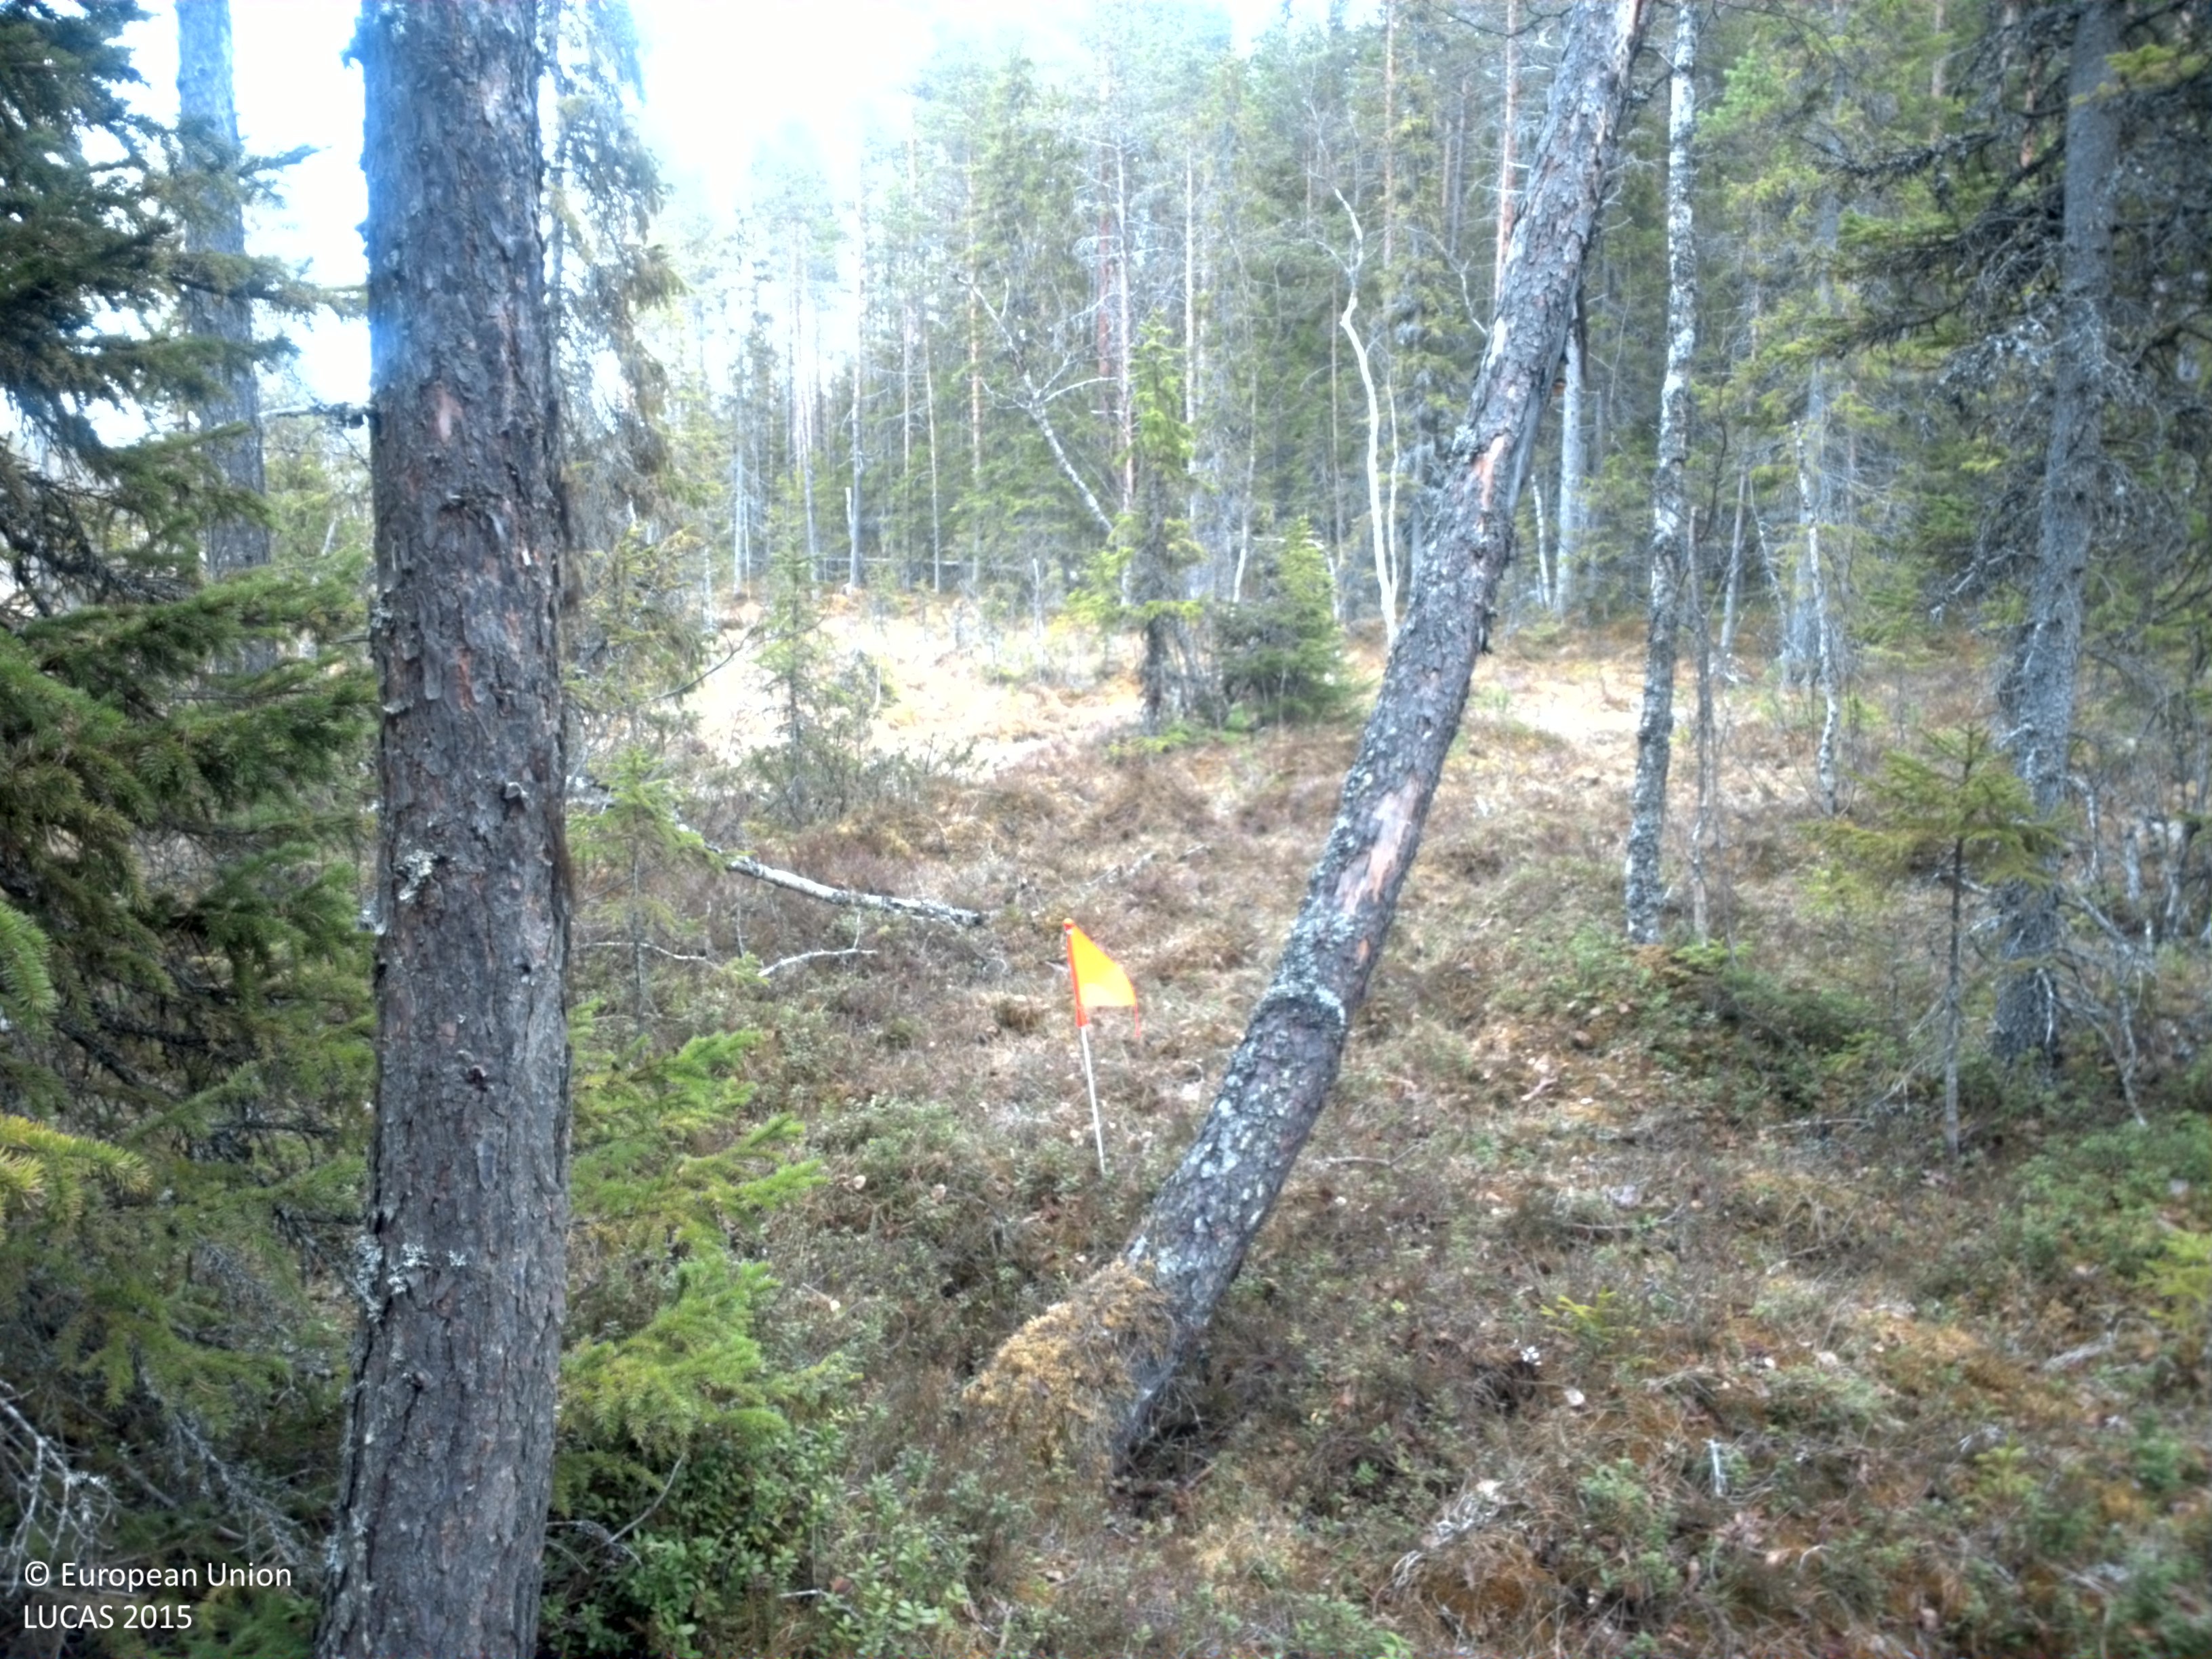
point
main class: Woodland
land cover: Other coniferous woodland
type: boreal forest
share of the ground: > 75 %
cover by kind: coniferous forest trees 75 %, shrubs 20 %, lichens and mosses 5 %
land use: Forestry
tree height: > 5 m
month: May
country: SE
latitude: 63.3596
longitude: 15.0343
